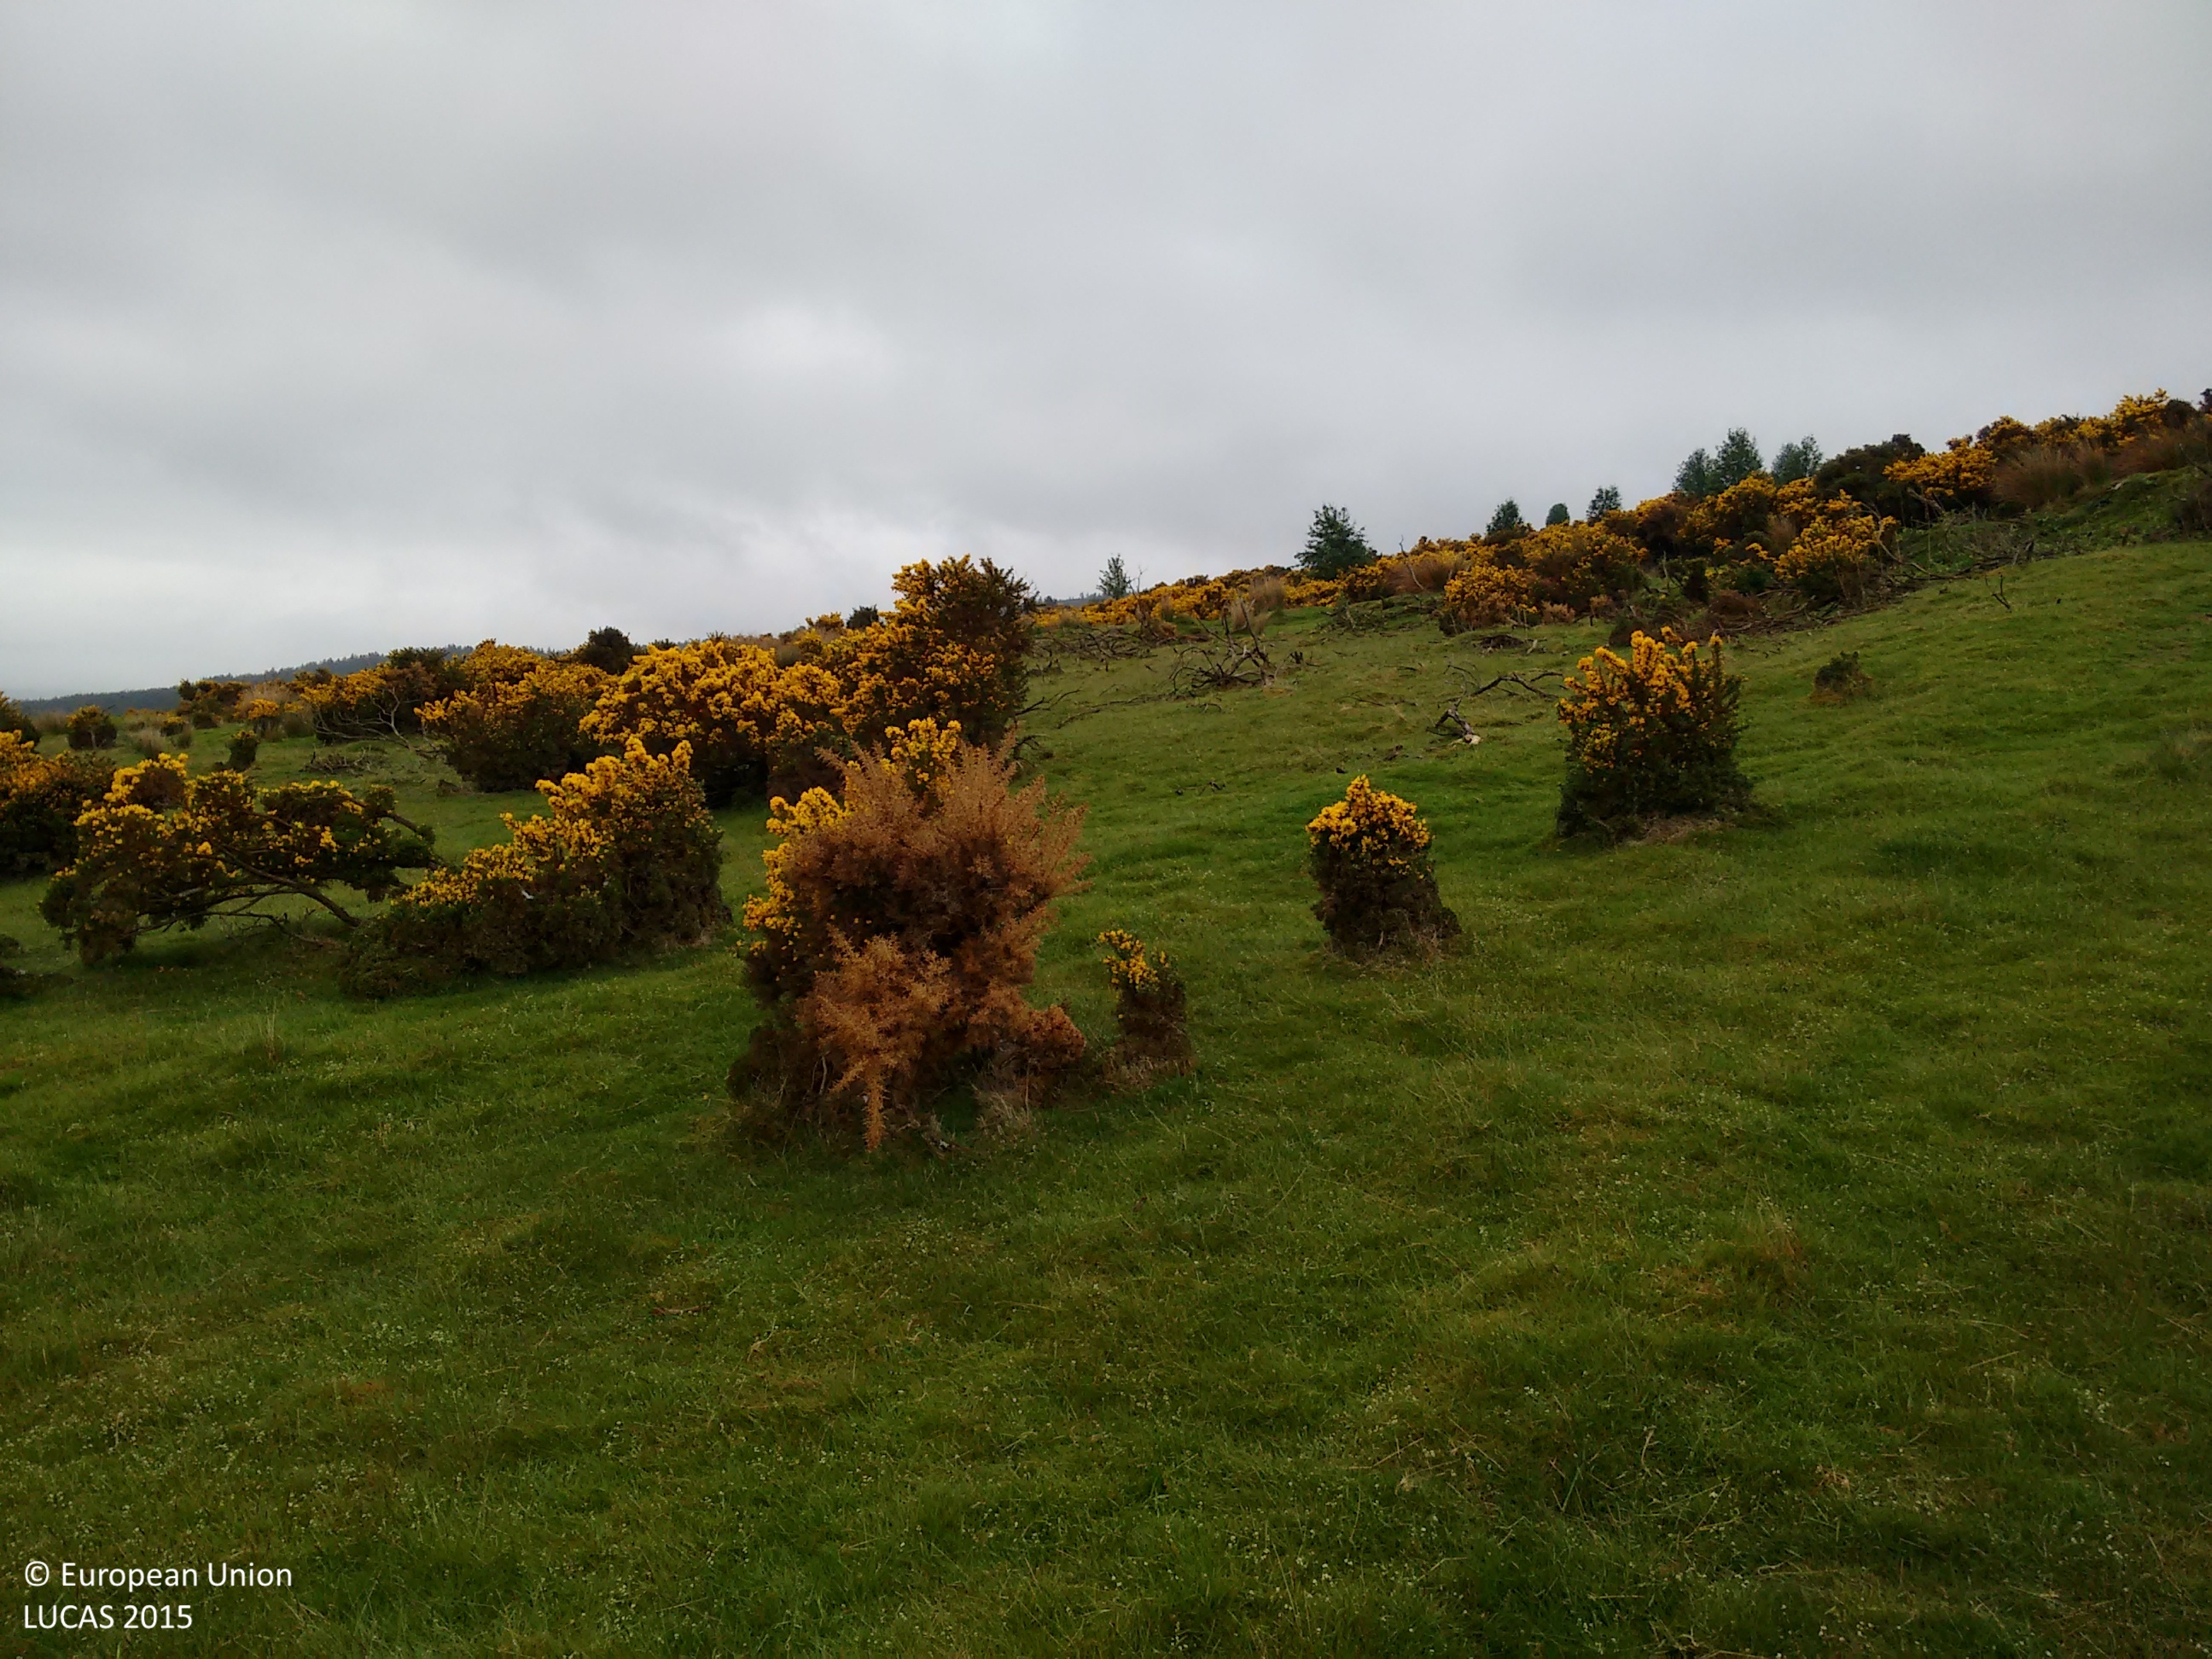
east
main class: Grassland
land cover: Grassland without tree/shrub cover
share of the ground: > 75 %
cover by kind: herbaceous plants 95 %, shrubs 5 %
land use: Agriculture (excluding fallow land and kitchen gardens)
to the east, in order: Grassland without tree/shrub cover; Shrubland without tree cover; Tracks; Shrubland without tree cover; Single bushes/trees; Shrubland without tree cover; Shrubland with sparse tree cover; Shrubland without tree cover
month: June
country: GB
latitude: 57.0243
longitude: -2.7603
